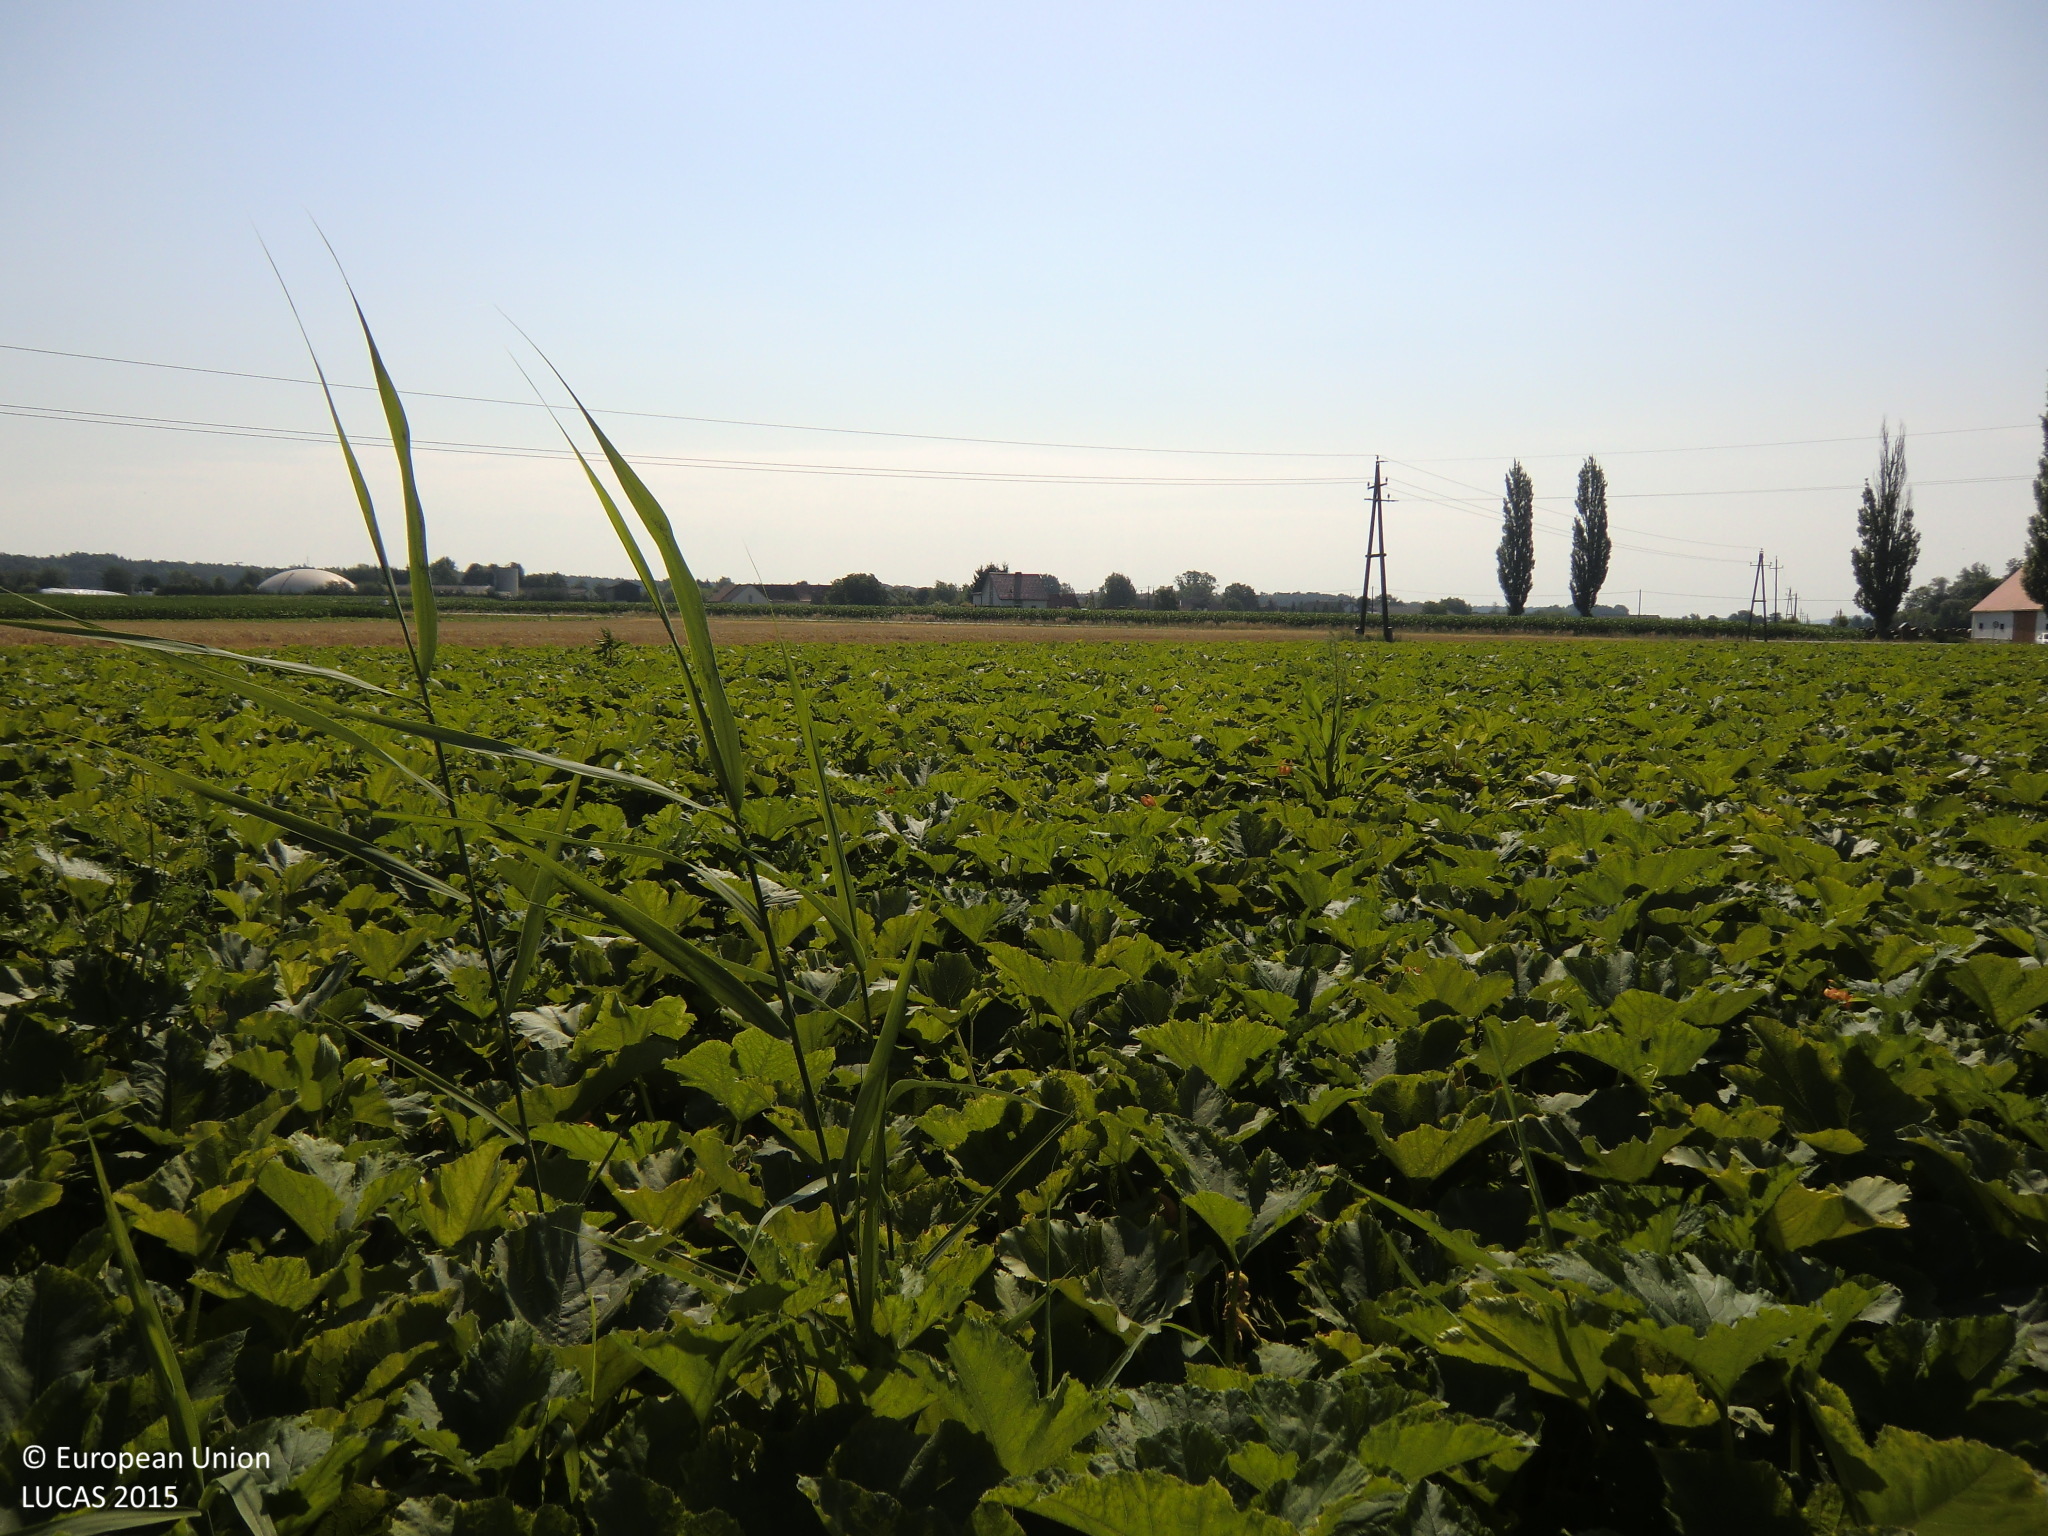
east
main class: Cropland
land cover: Other fibre and oleaginous crops
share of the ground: > 75 %
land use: Agriculture (excluding fallow land and kitchen gardens)
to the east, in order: Other fibre and oleaginous crops; Electric lines; Barley; Grass margins; Ditches and canals; Paved roads, cycling and walking lanes; Ditches and canals; Grass margins; Maize
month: July
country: AT
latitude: 47.1261
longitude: 15.9199
